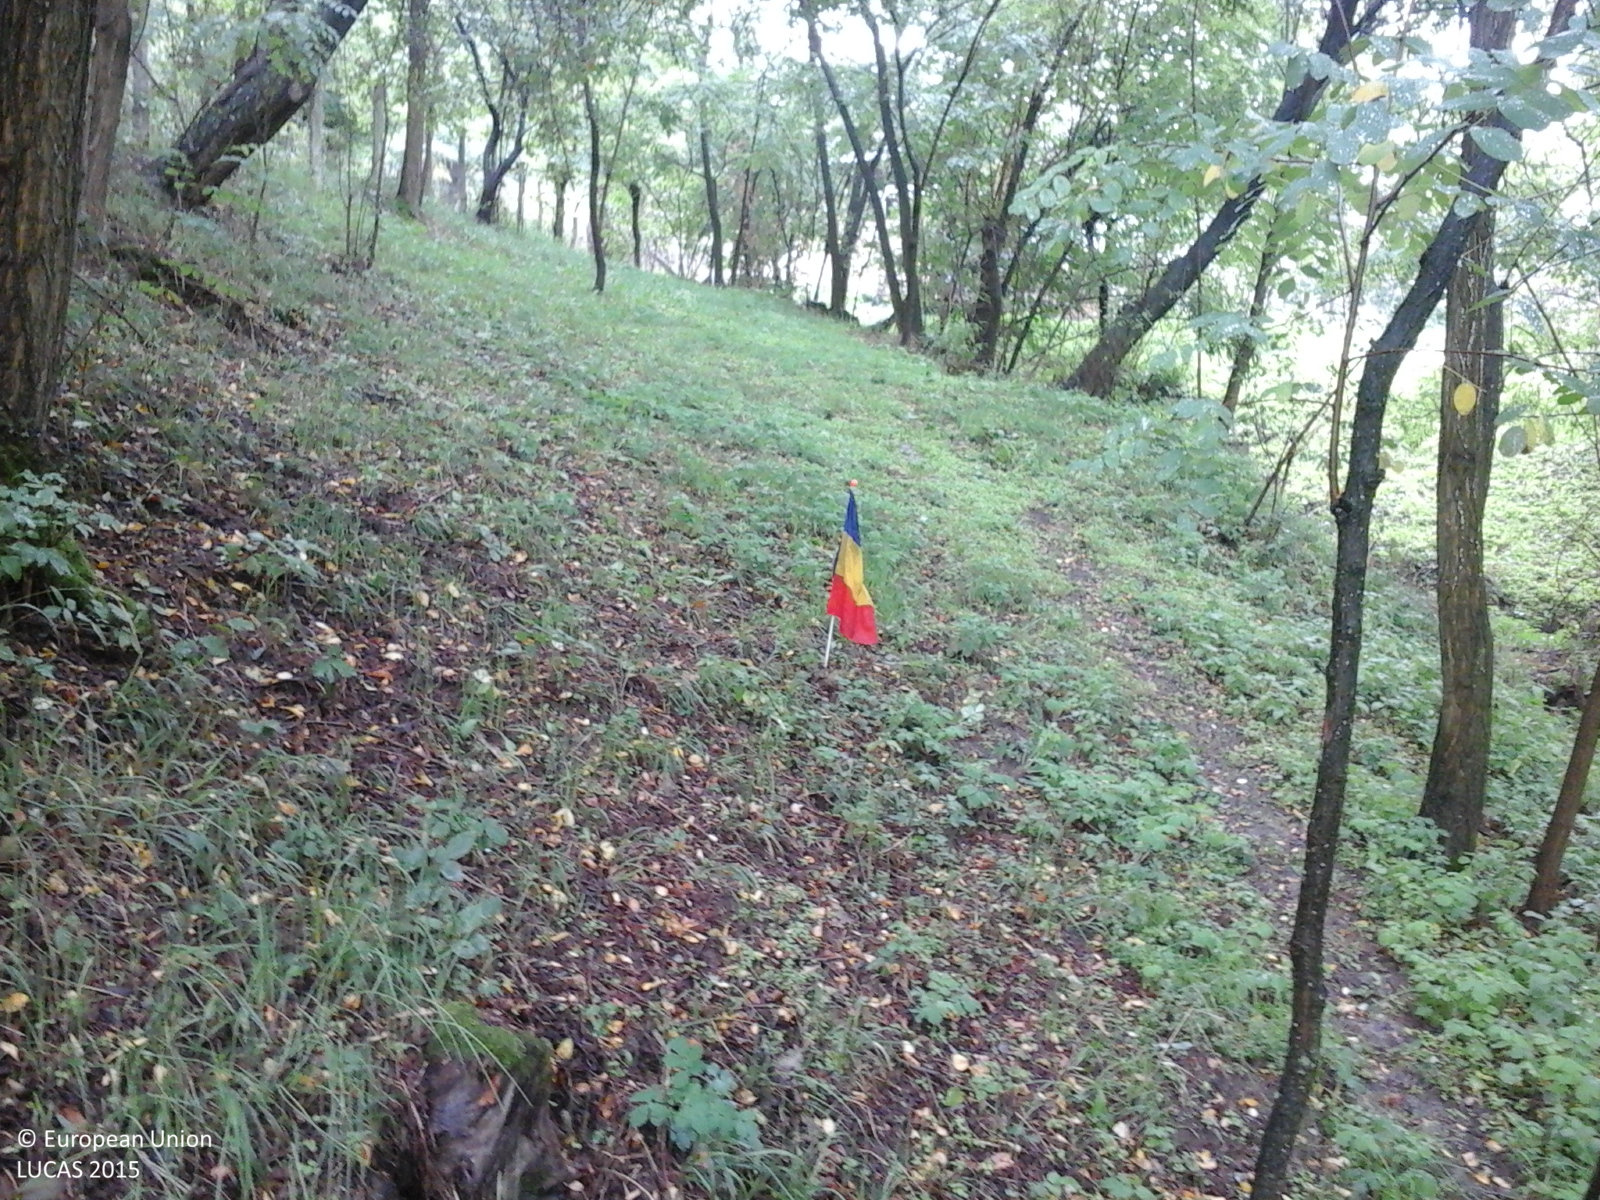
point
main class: Woodland
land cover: Broadleaved woodland
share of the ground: > 75 %
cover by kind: broadleaved forest trees 100 %
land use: Forestry
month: September
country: RO
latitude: 45.1571
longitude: 24.4890
